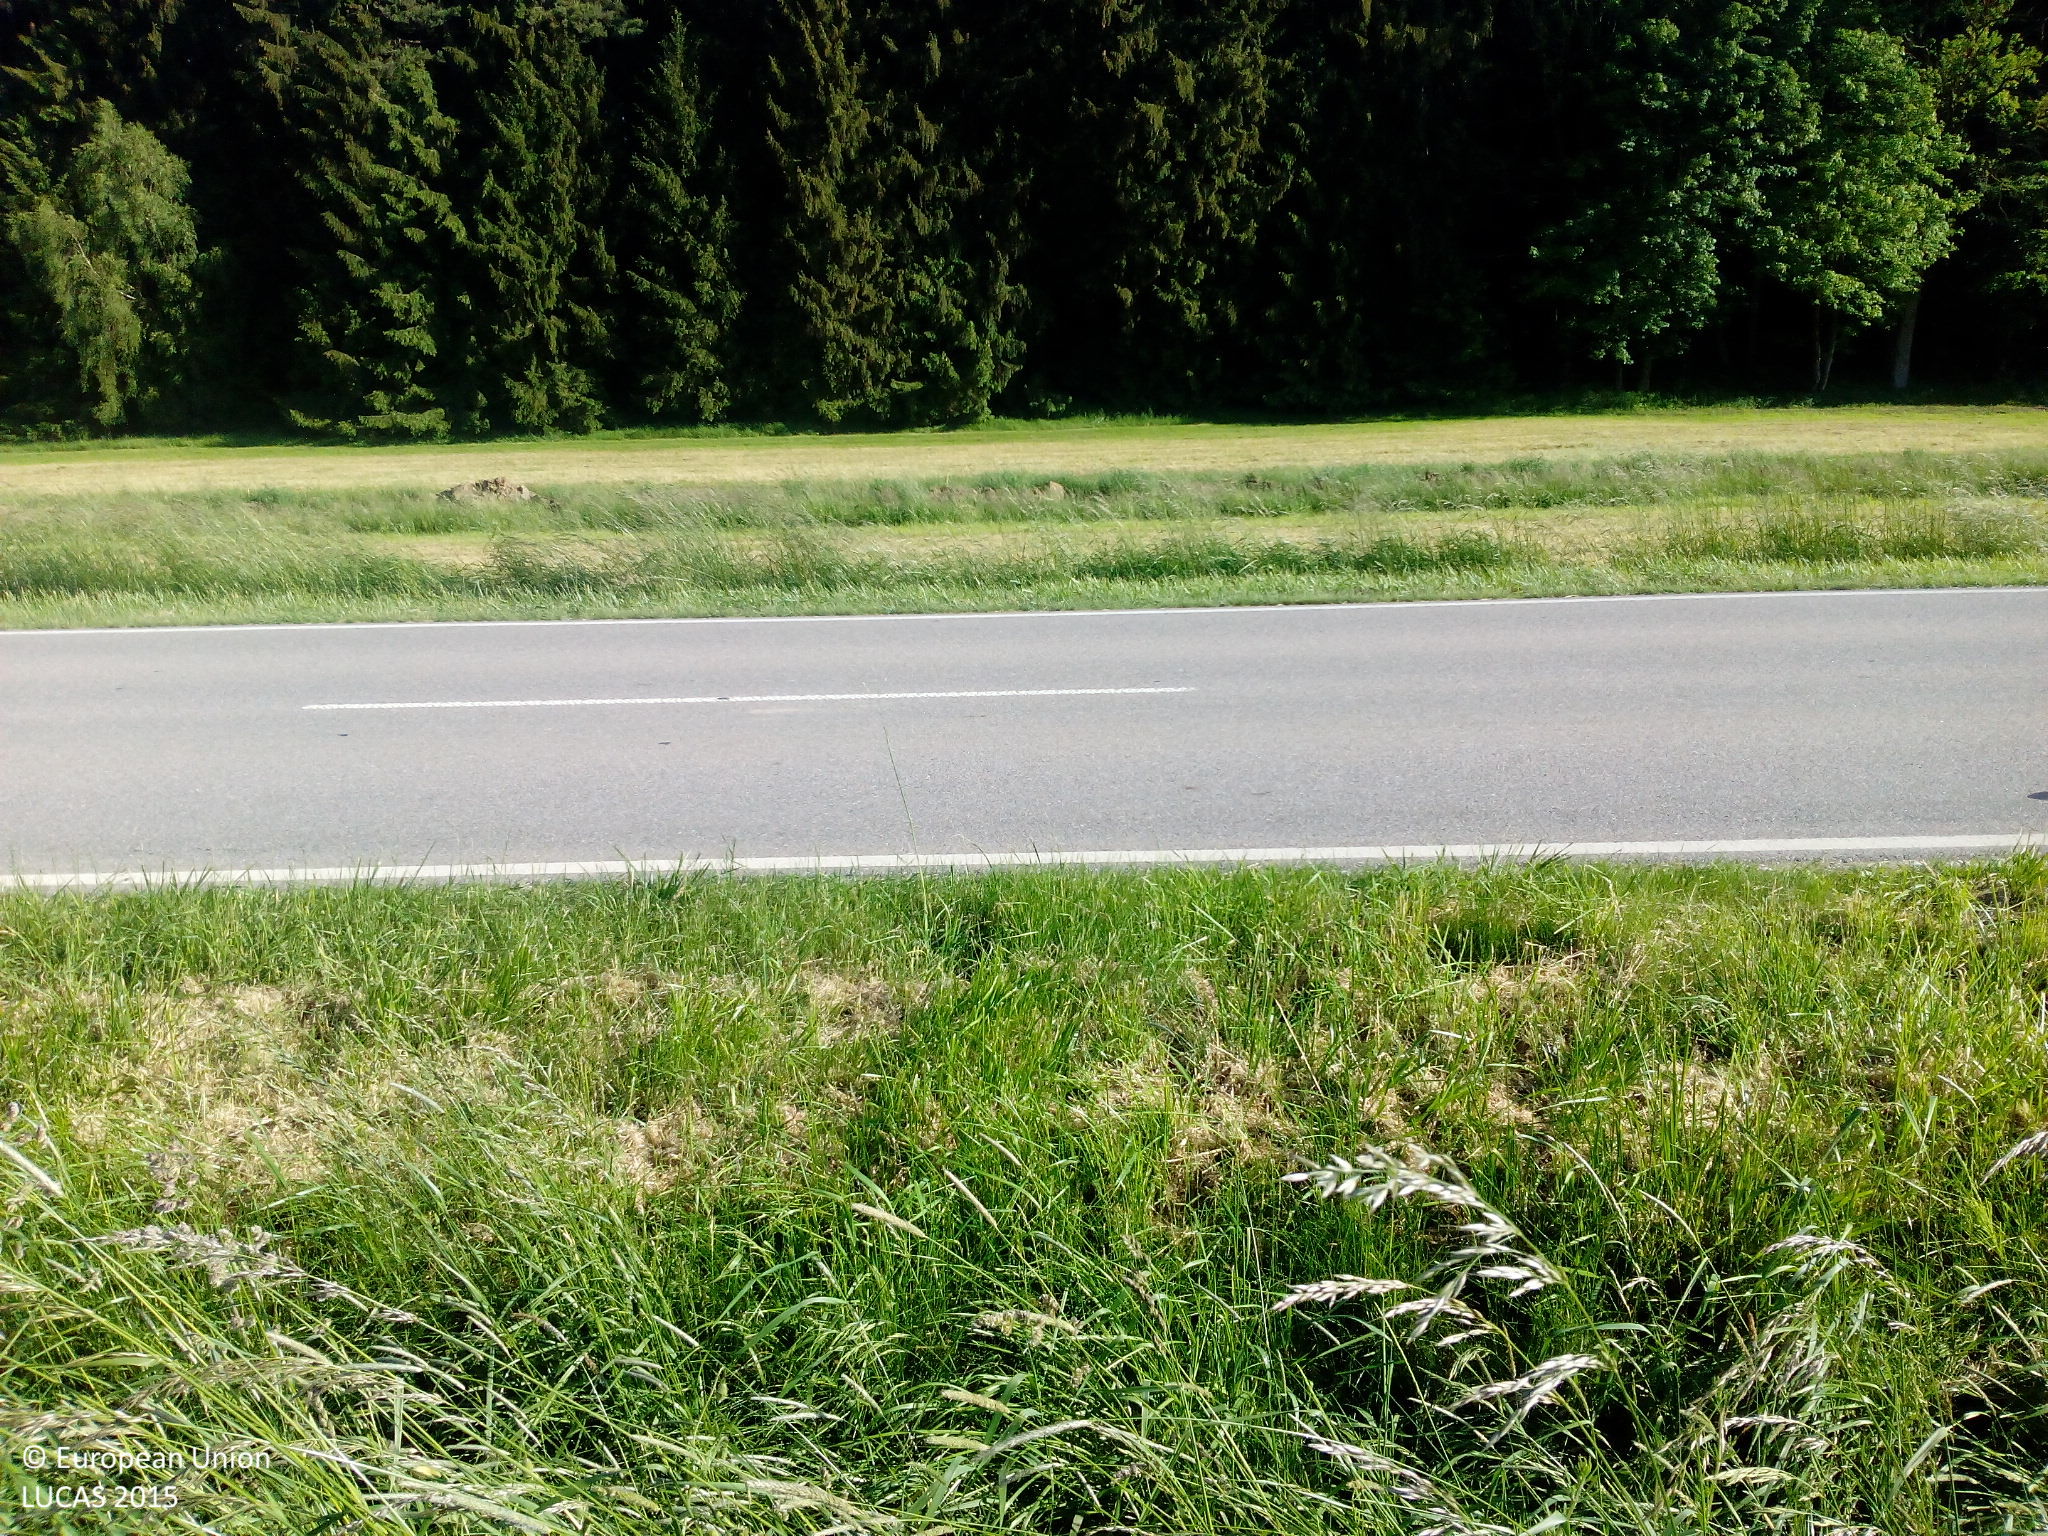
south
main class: Cropland
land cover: Common wheat
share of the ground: > 75 %
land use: Agriculture (excluding fallow land and kitchen gardens)
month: June
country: DE
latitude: 48.7079
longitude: 12.0784
